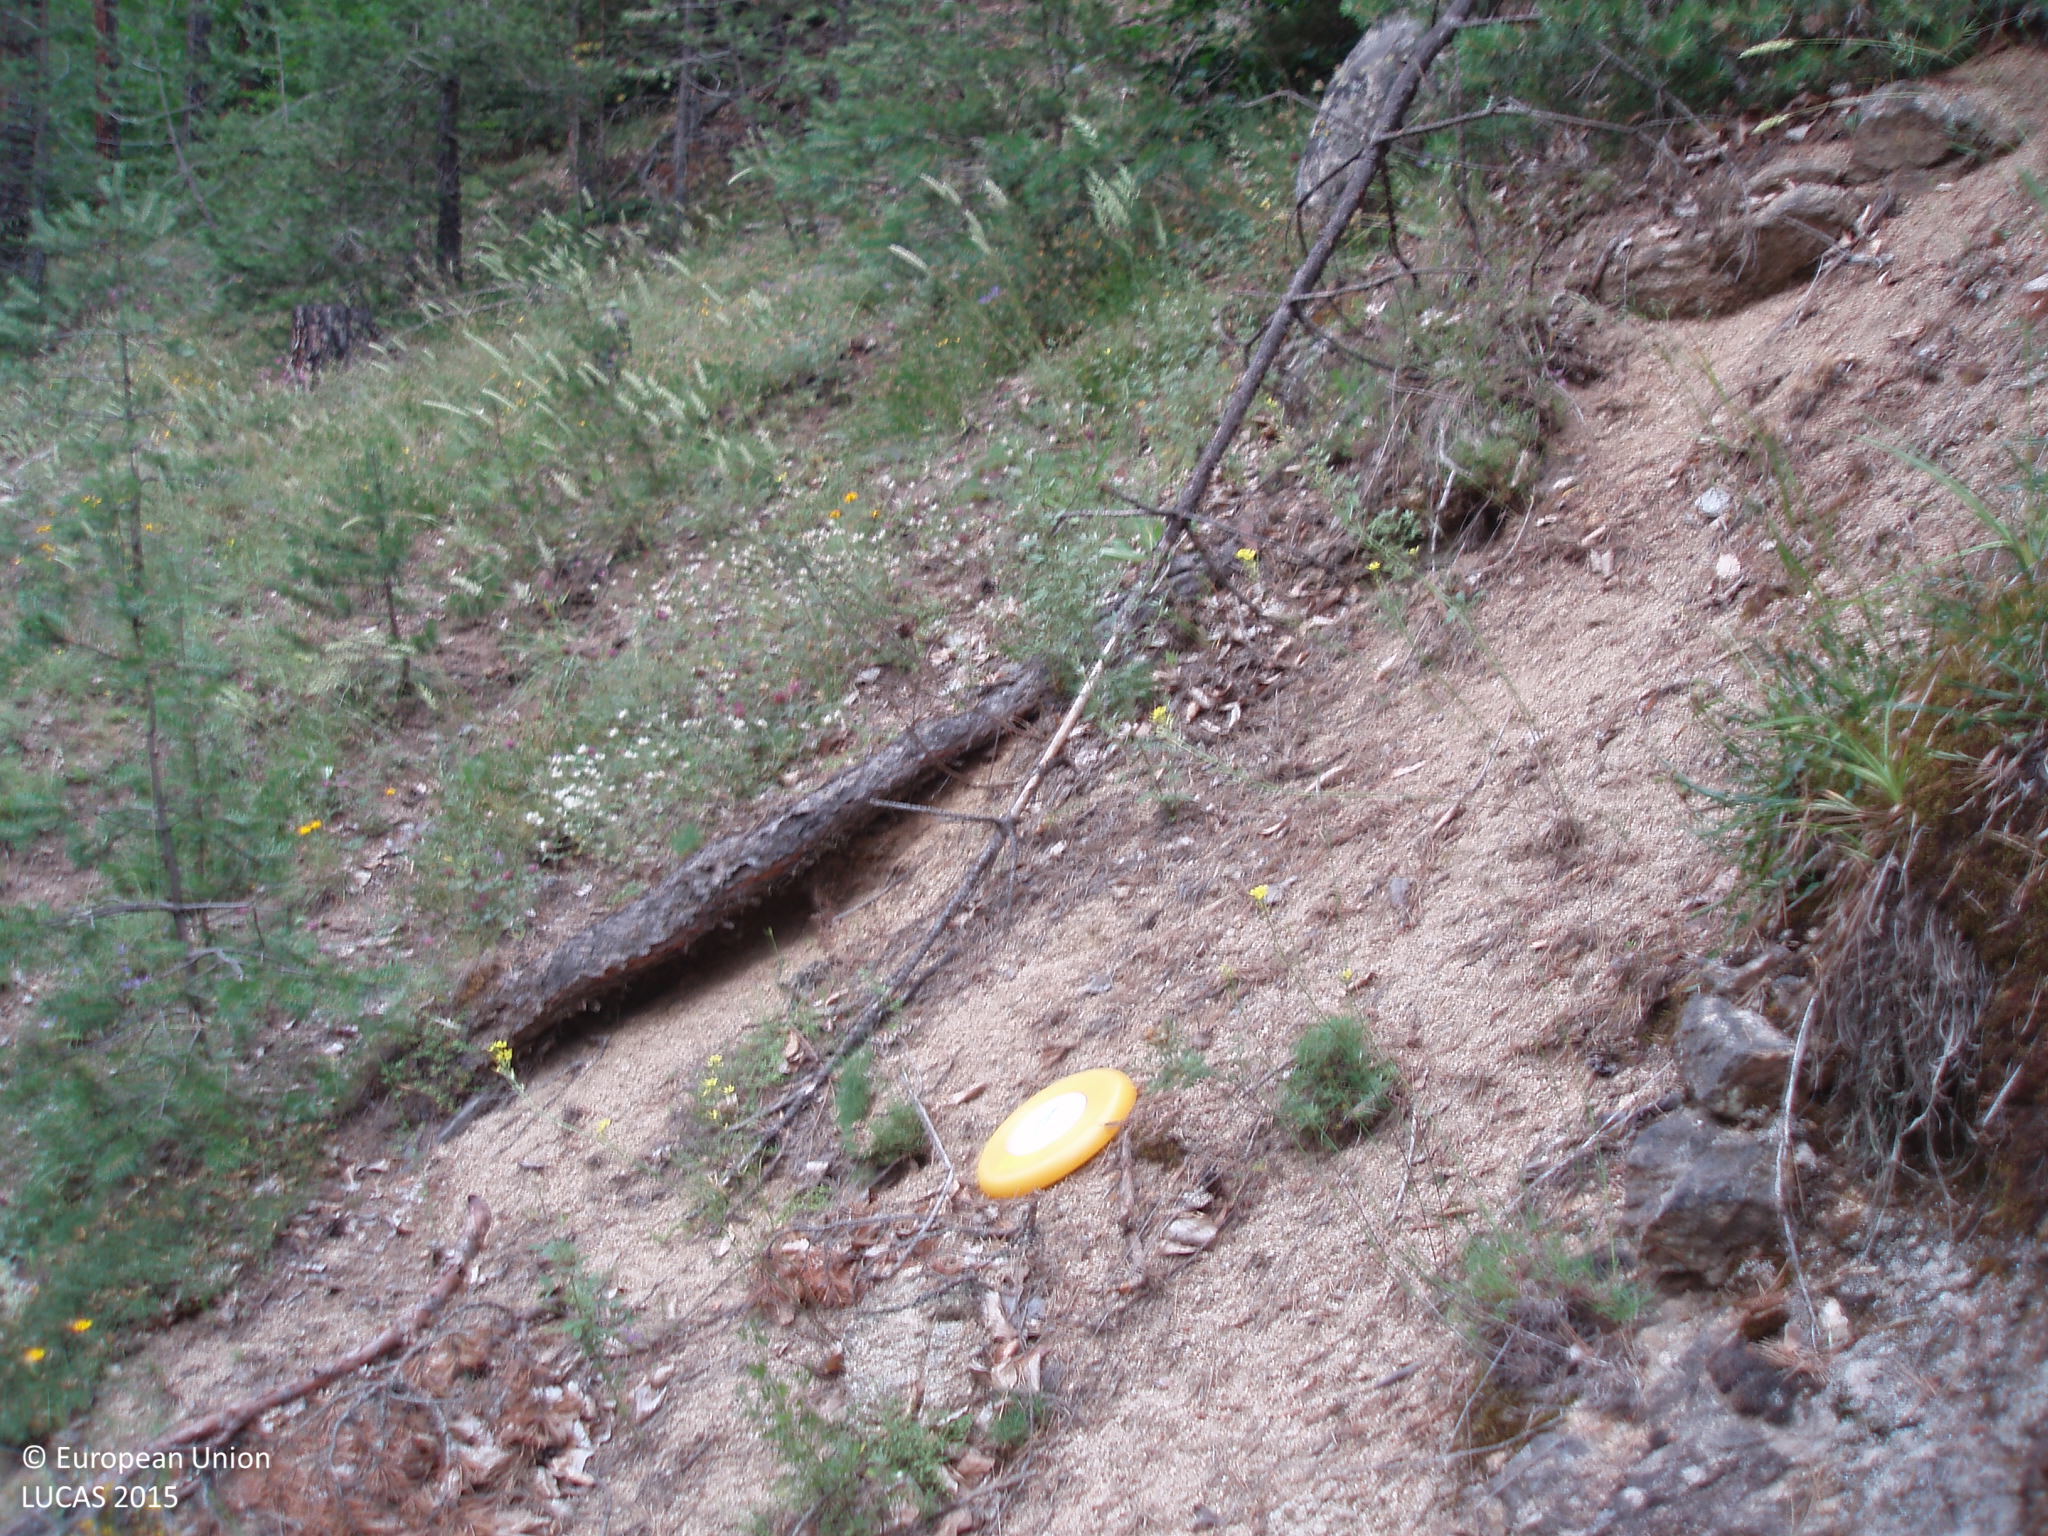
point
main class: Woodland
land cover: Other mixed woodland
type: hemiboreal forest and nemoral coniferous forest and mixed broadleaved-coniferous forest
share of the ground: 50 - 75 %
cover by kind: coniferous forest trees 65 %, broadleaved forest trees 25 %, herbaceous plants 10 %
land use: Forestry
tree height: > 5 m
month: July
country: BG
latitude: 42.0412
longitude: 23.7452
